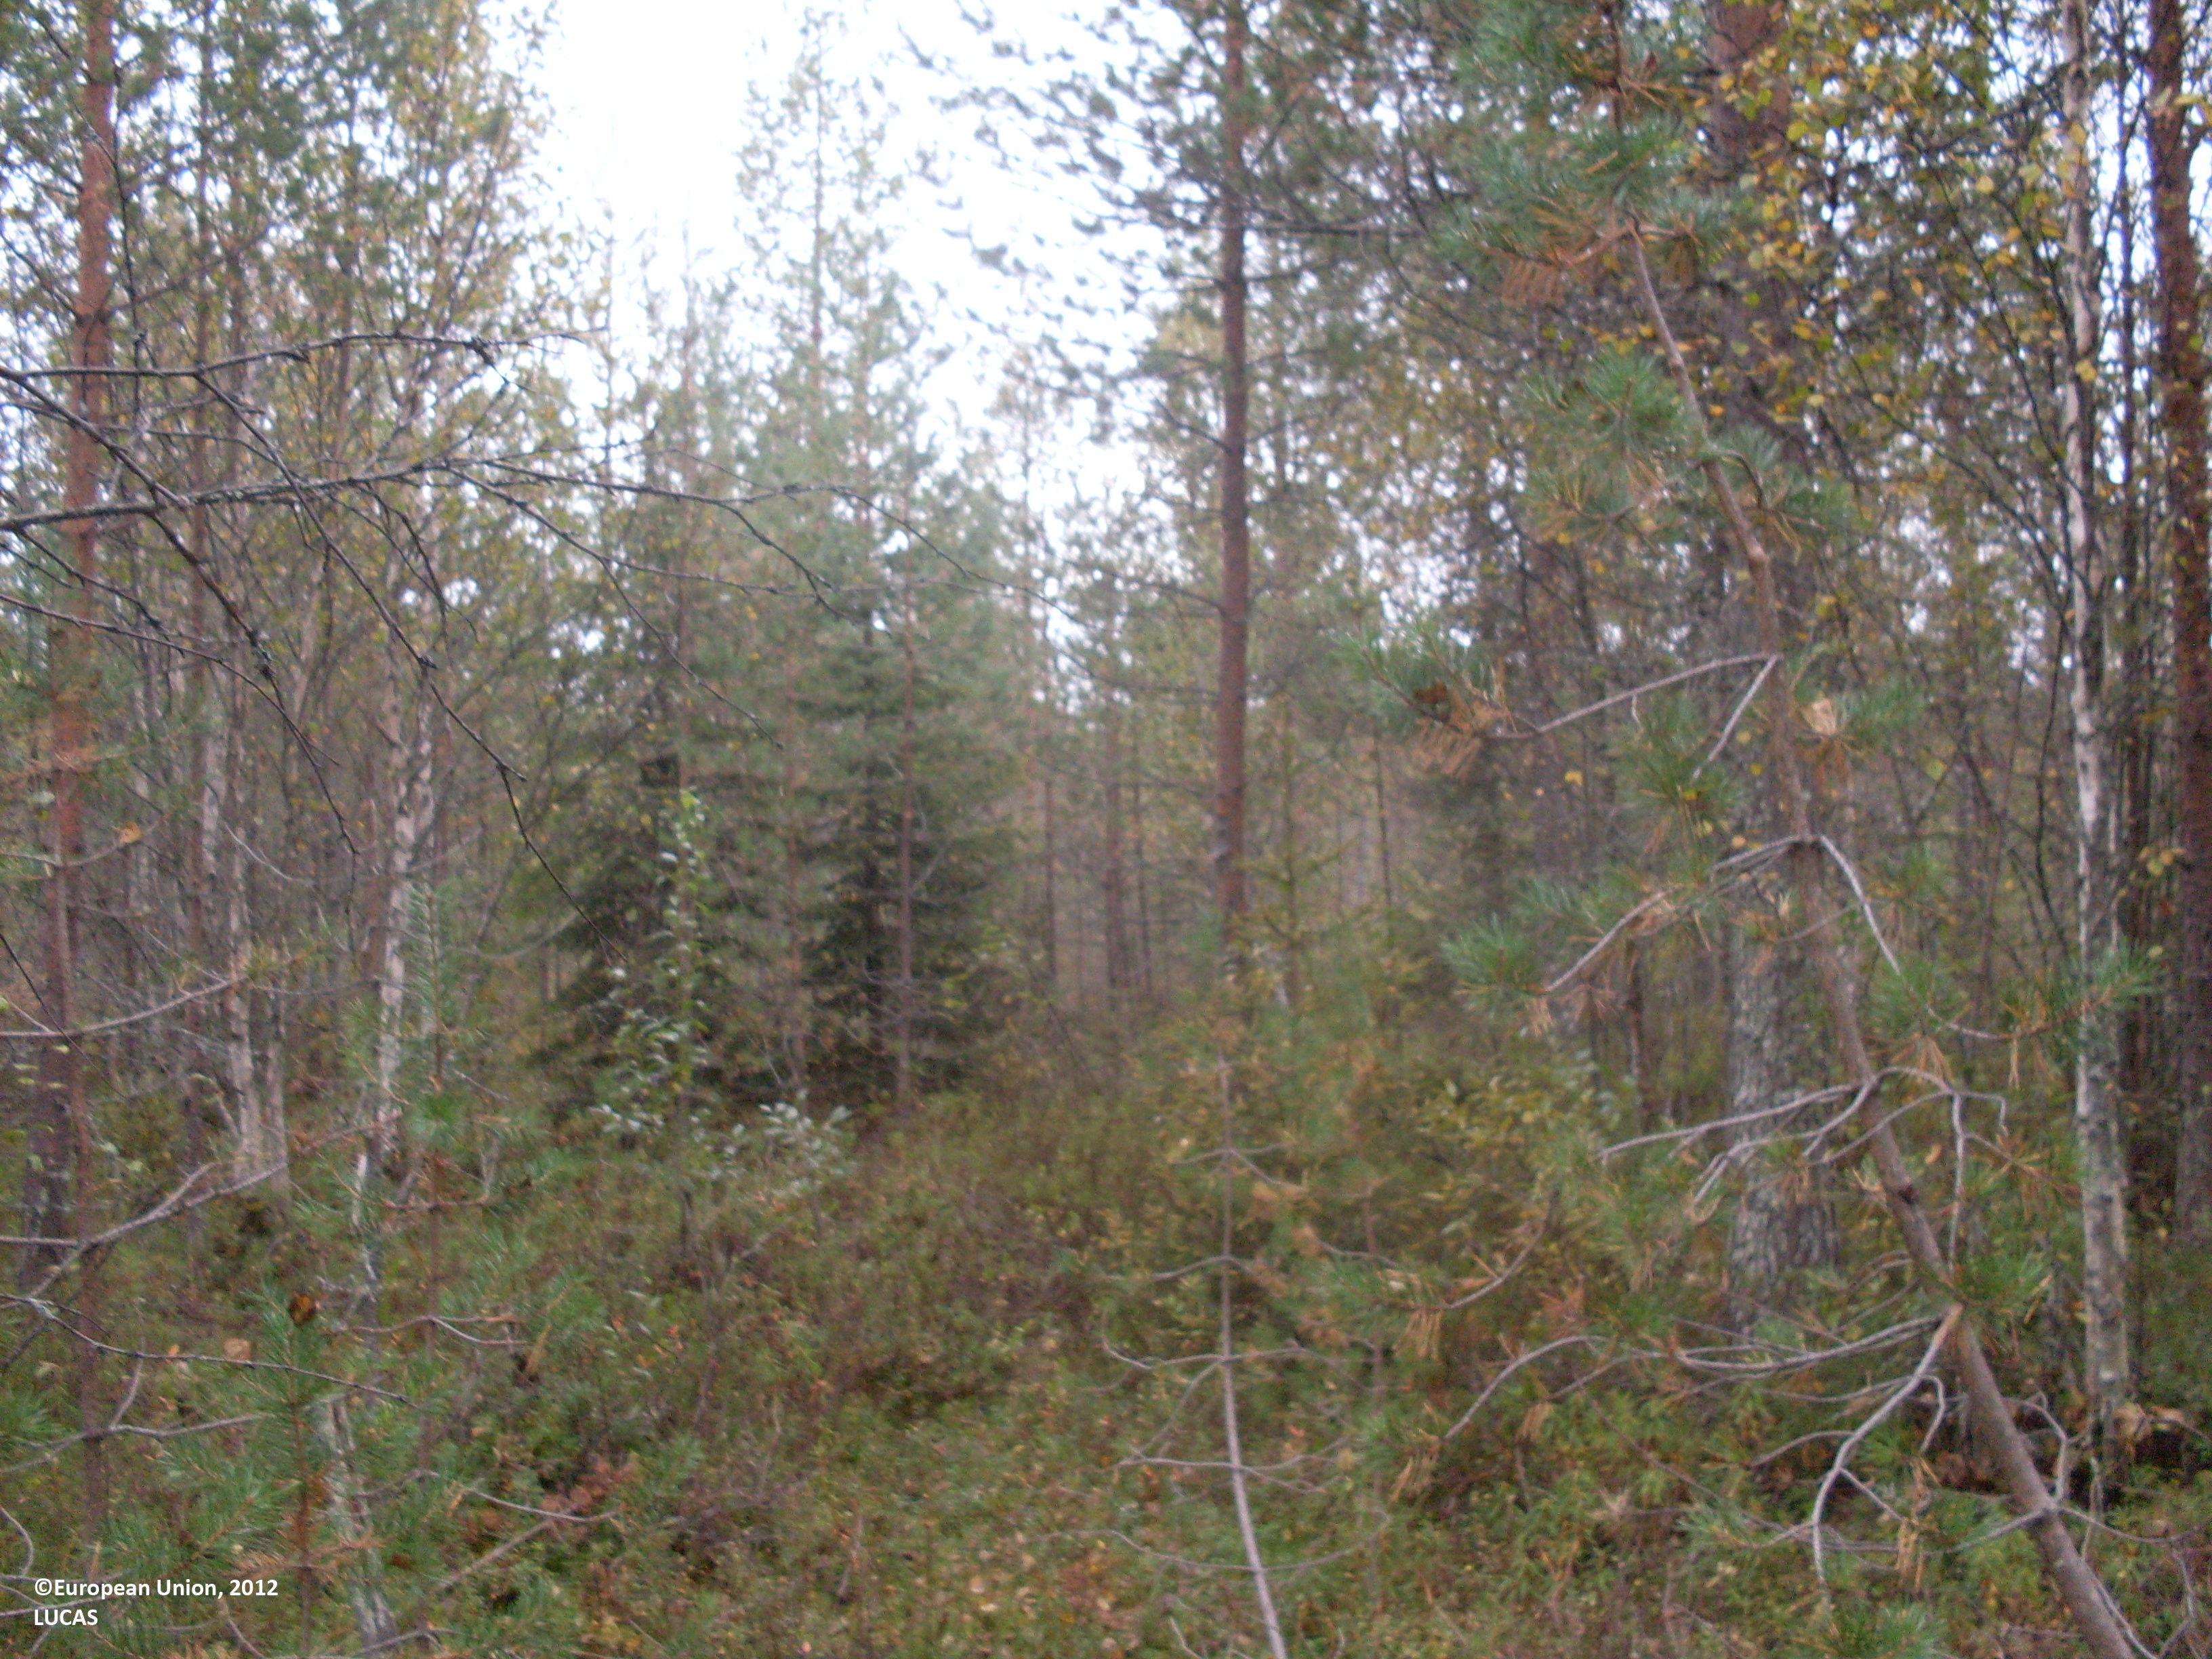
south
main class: Woodland
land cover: Other mixed woodland
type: boreal forest
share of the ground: 50 - 75 %
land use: Forestry
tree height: > 5 m
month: September
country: FI
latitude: 63.9750
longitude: 29.7814
